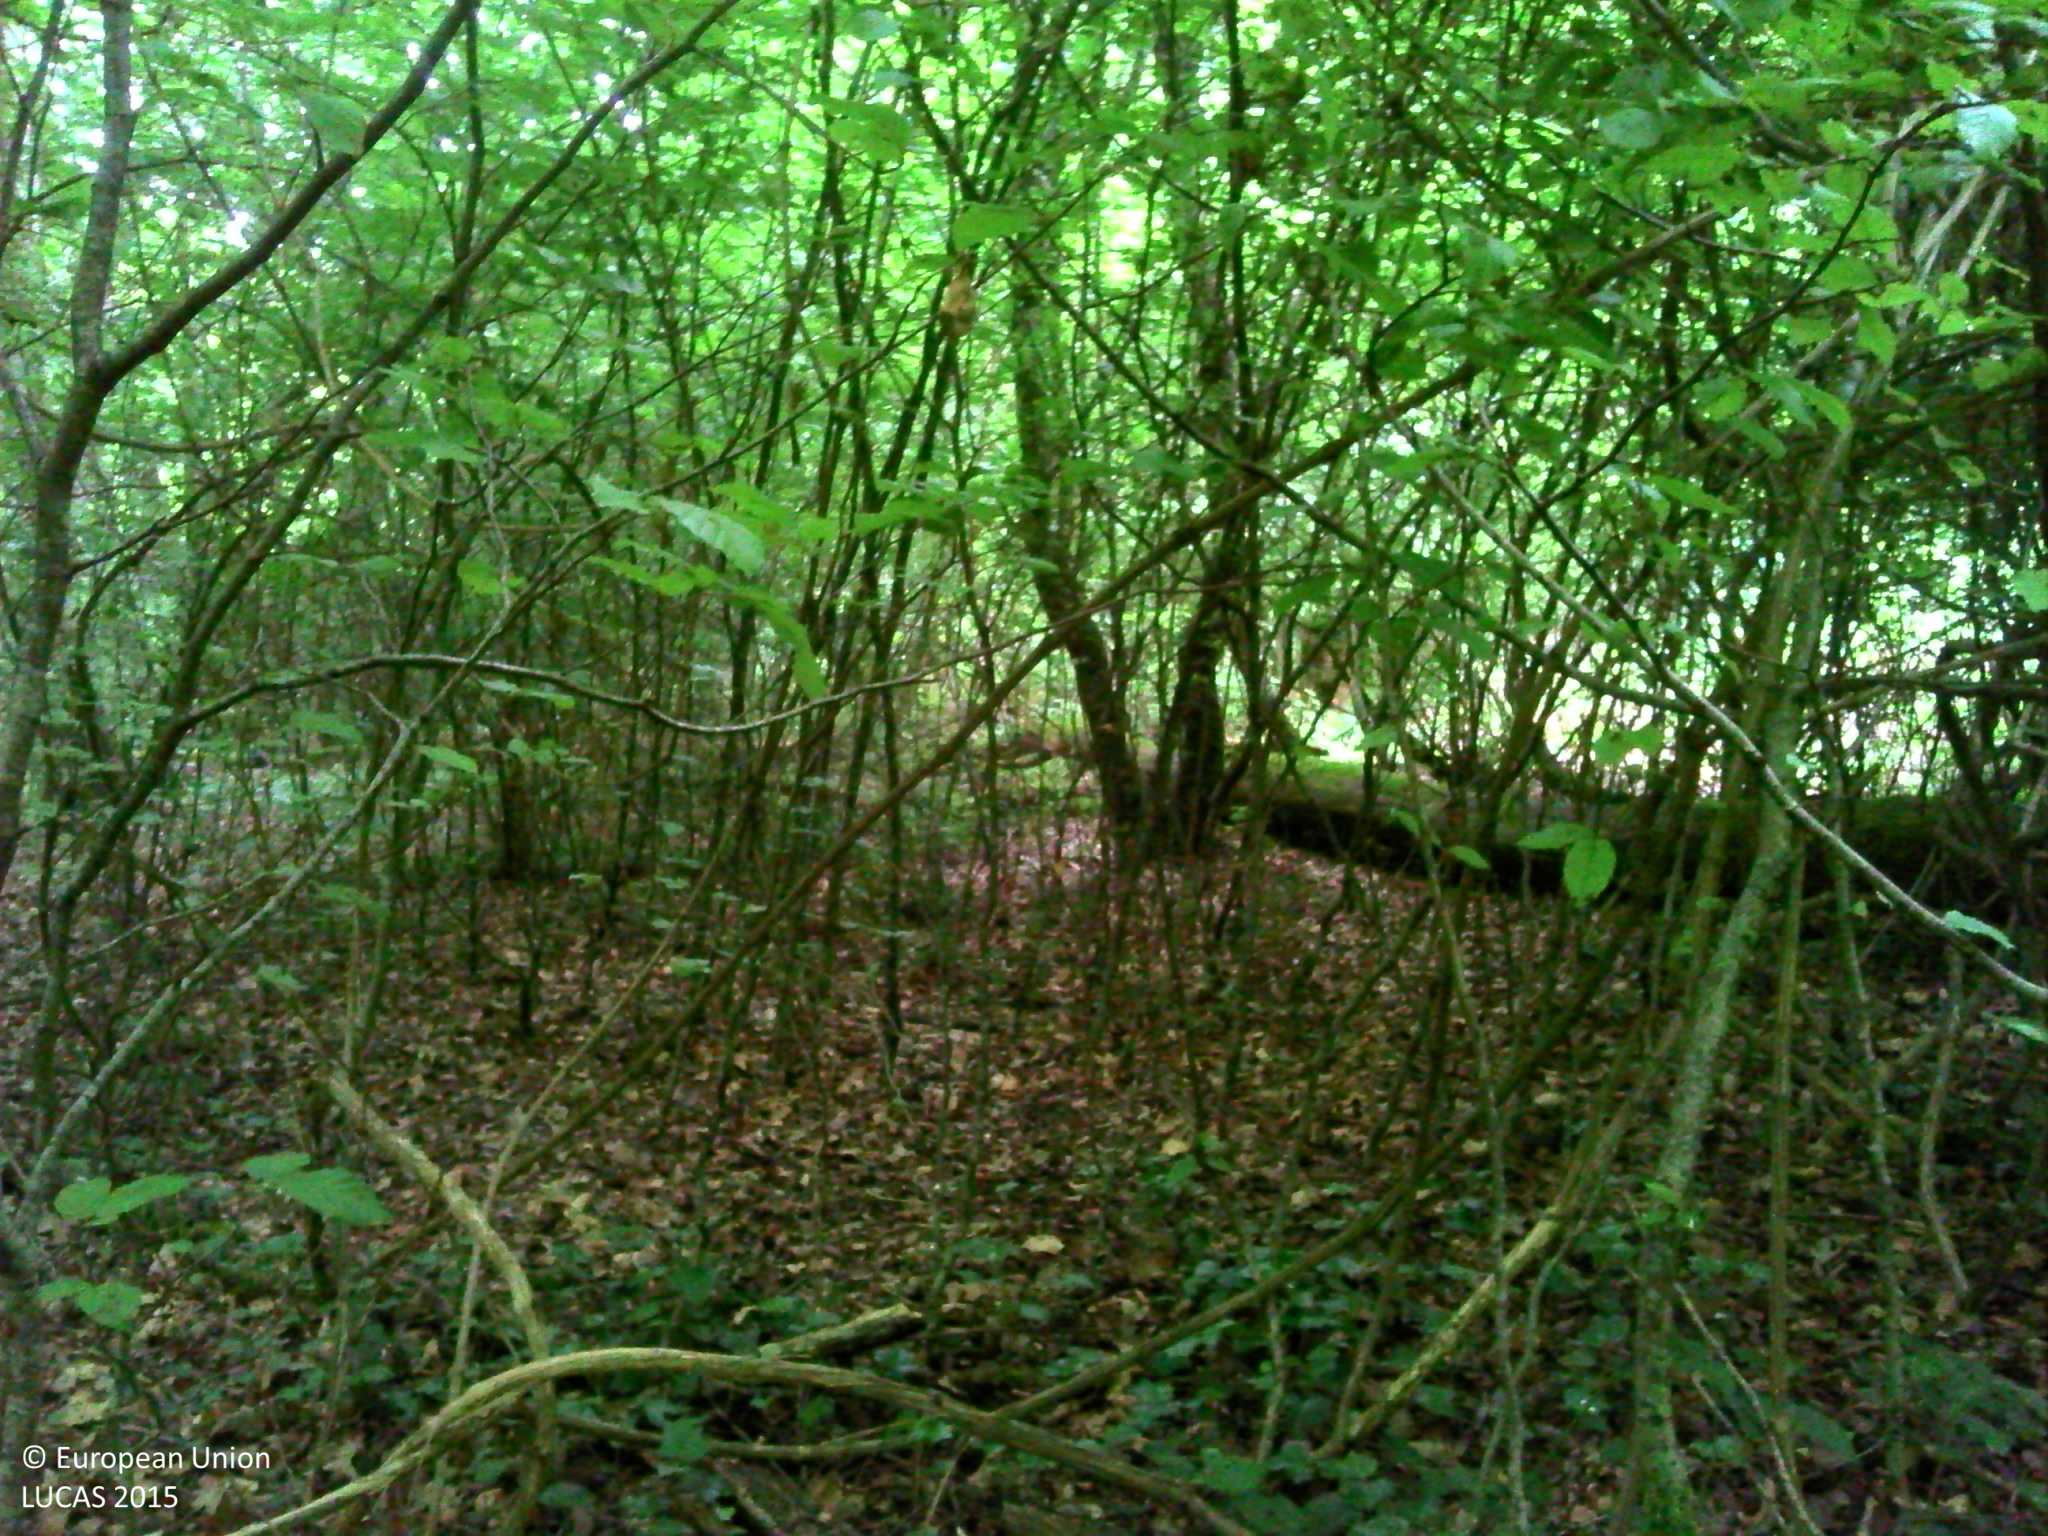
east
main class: Woodland
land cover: Broadleaved woodland
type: mesophytic deciduous forest
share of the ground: > 75 %
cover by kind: broadleaved forest trees 90 %, herbaceous plants 5 %, lichens and mosses 5 %
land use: Forestry
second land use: Amenities, museums, leisure
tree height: > 5 m
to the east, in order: Broadleaved woodland
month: June
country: FR
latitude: 48.2835
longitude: 3.4852
